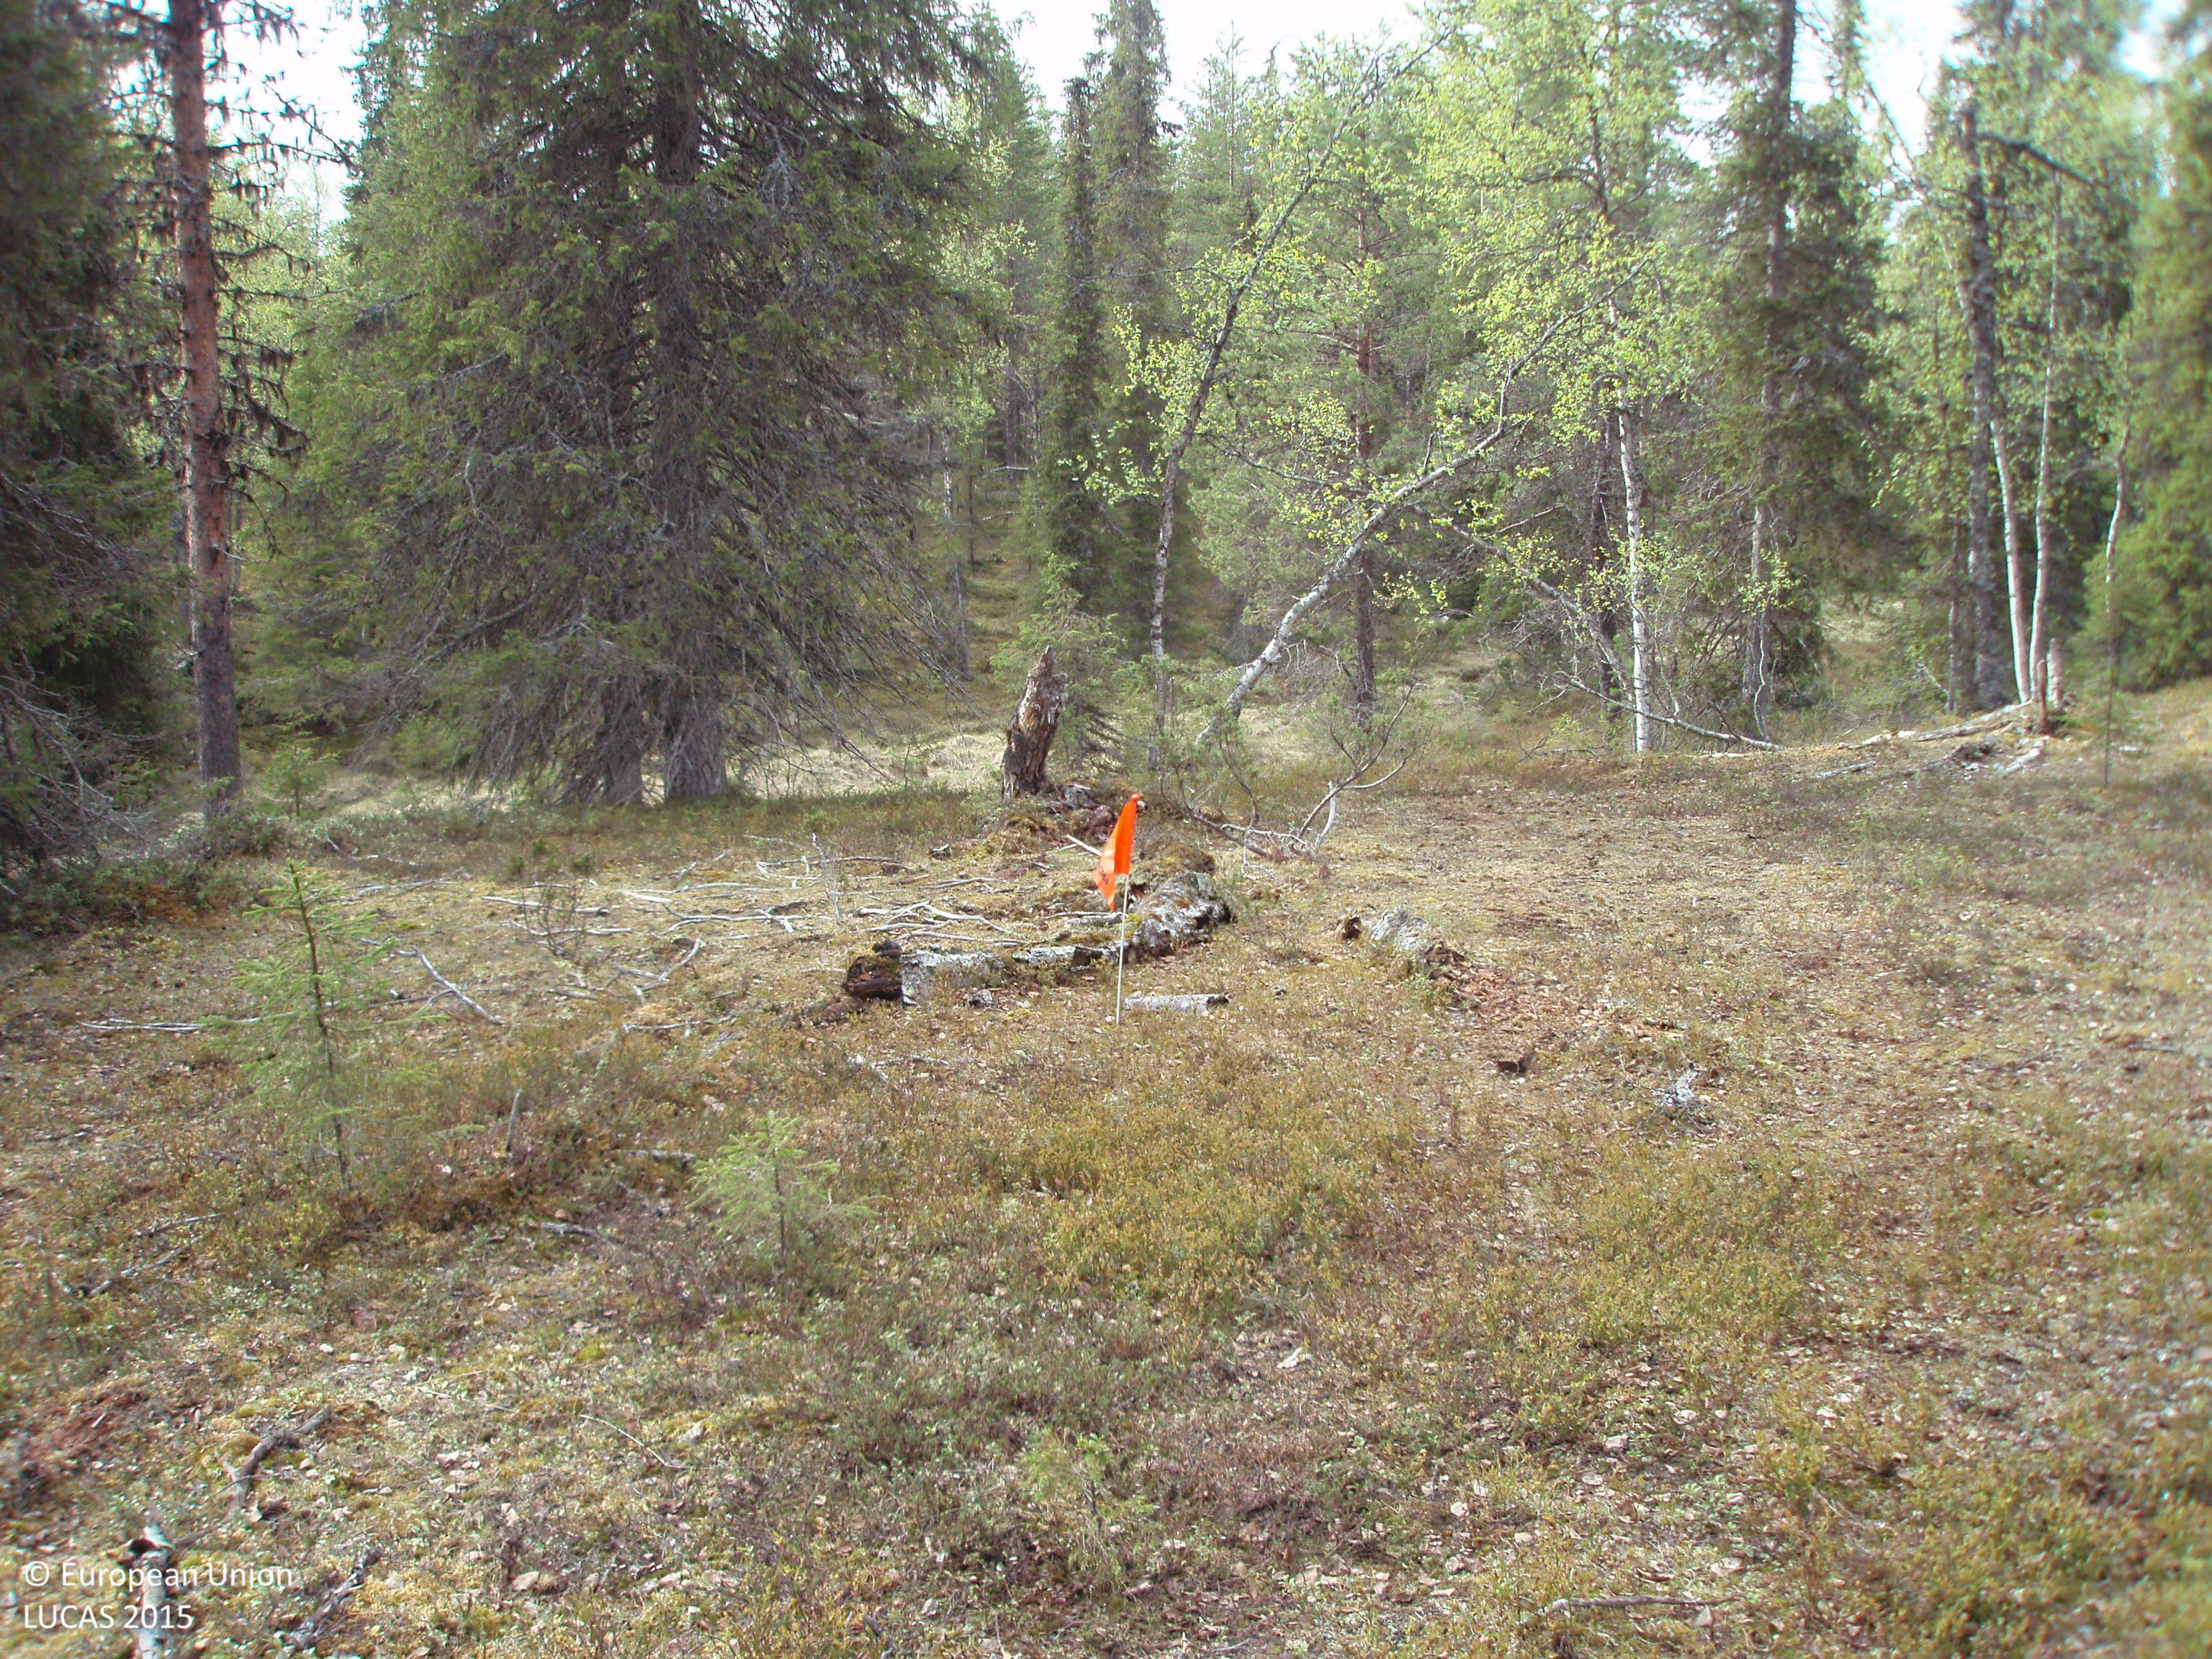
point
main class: Woodland
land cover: Other mixed woodland
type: boreal forest
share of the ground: 50 - 75 %
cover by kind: coniferous forest trees 50 %, broadleaved forest trees 20 %, shrubs 20 %, lichens and mosses 10 %
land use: Forestry
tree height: > 5 m
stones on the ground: 10 - 25 %
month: June
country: FI
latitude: 68.2769
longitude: 26.9936
